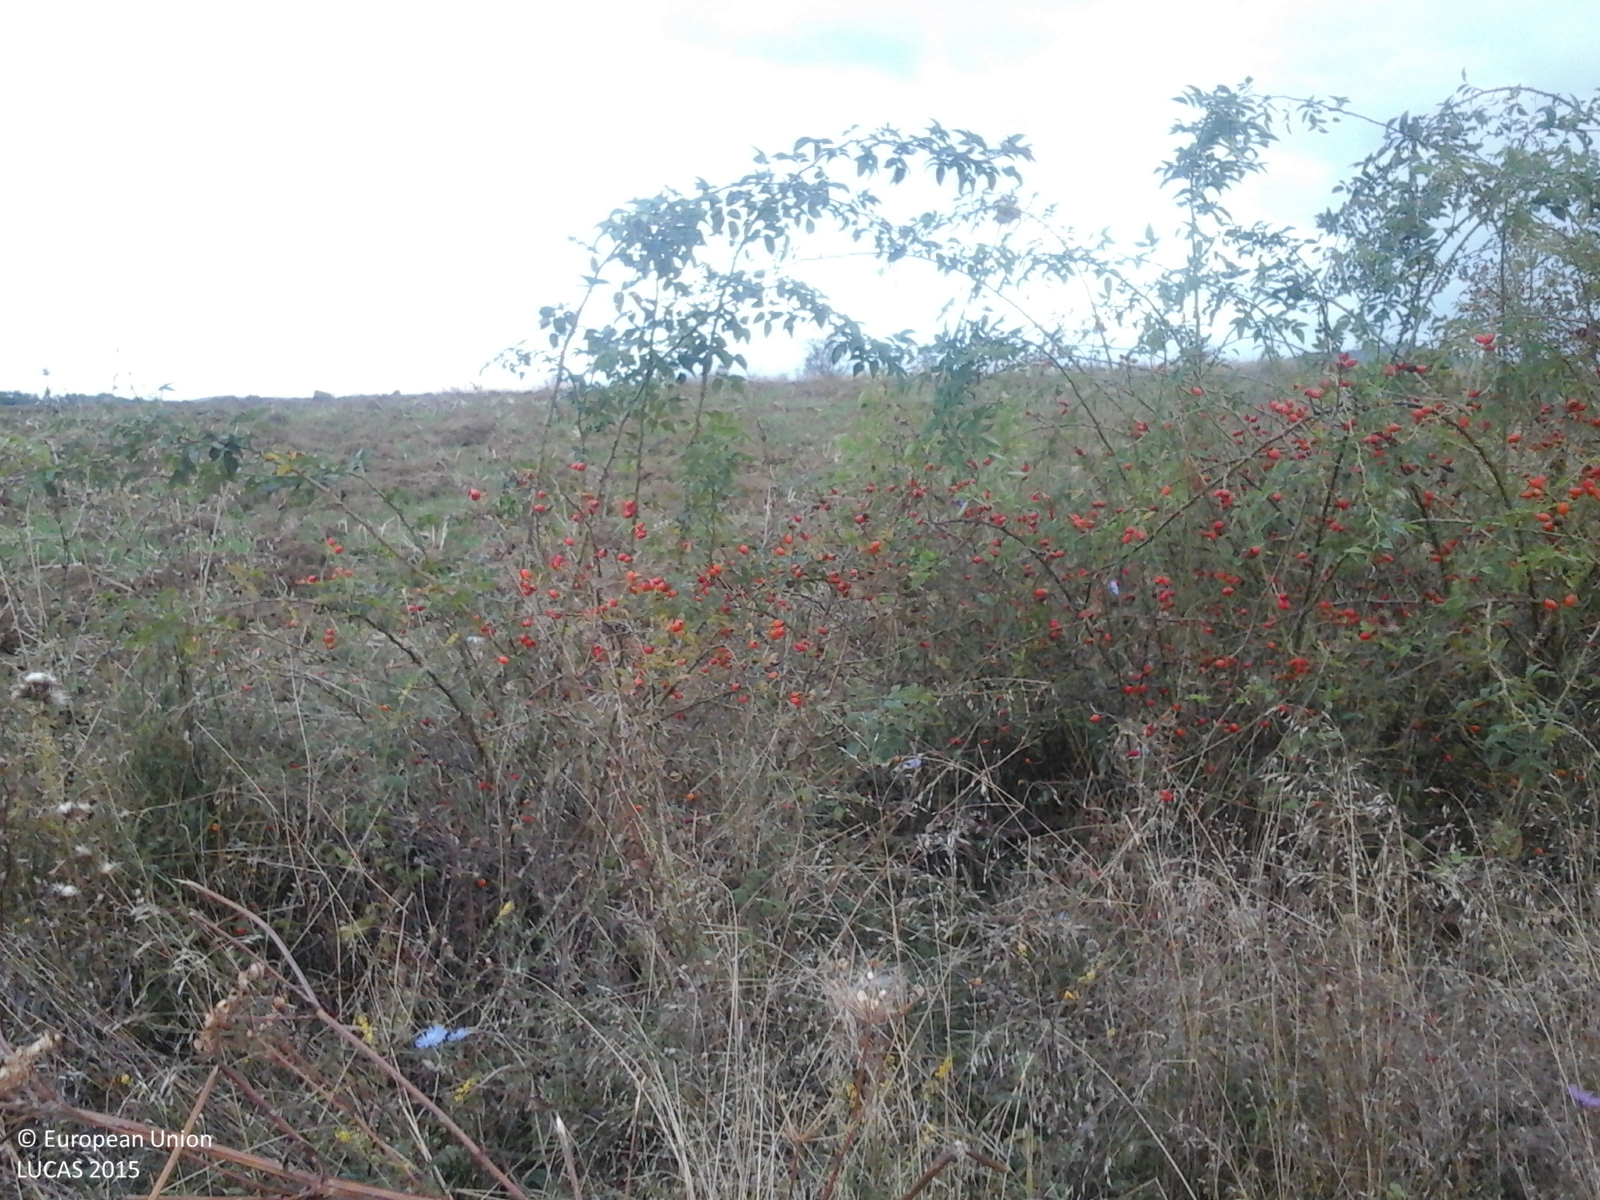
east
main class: Shrubland
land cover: Shrubland with sparse tree cover
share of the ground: > 75 %
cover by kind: herbaceous plants 65 %, shrubs 30 %, broadleaved forest trees 5 %
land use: Fallow land
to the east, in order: Shrubland with sparse tree cover; Other bare soil; Spontaneously vegetated surfaces; Common wheat; Other bare soil; Common wheat; Spontaneously vegetated surfaces; Other bare soil
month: September
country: RO
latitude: 47.1547
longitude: 23.0286
